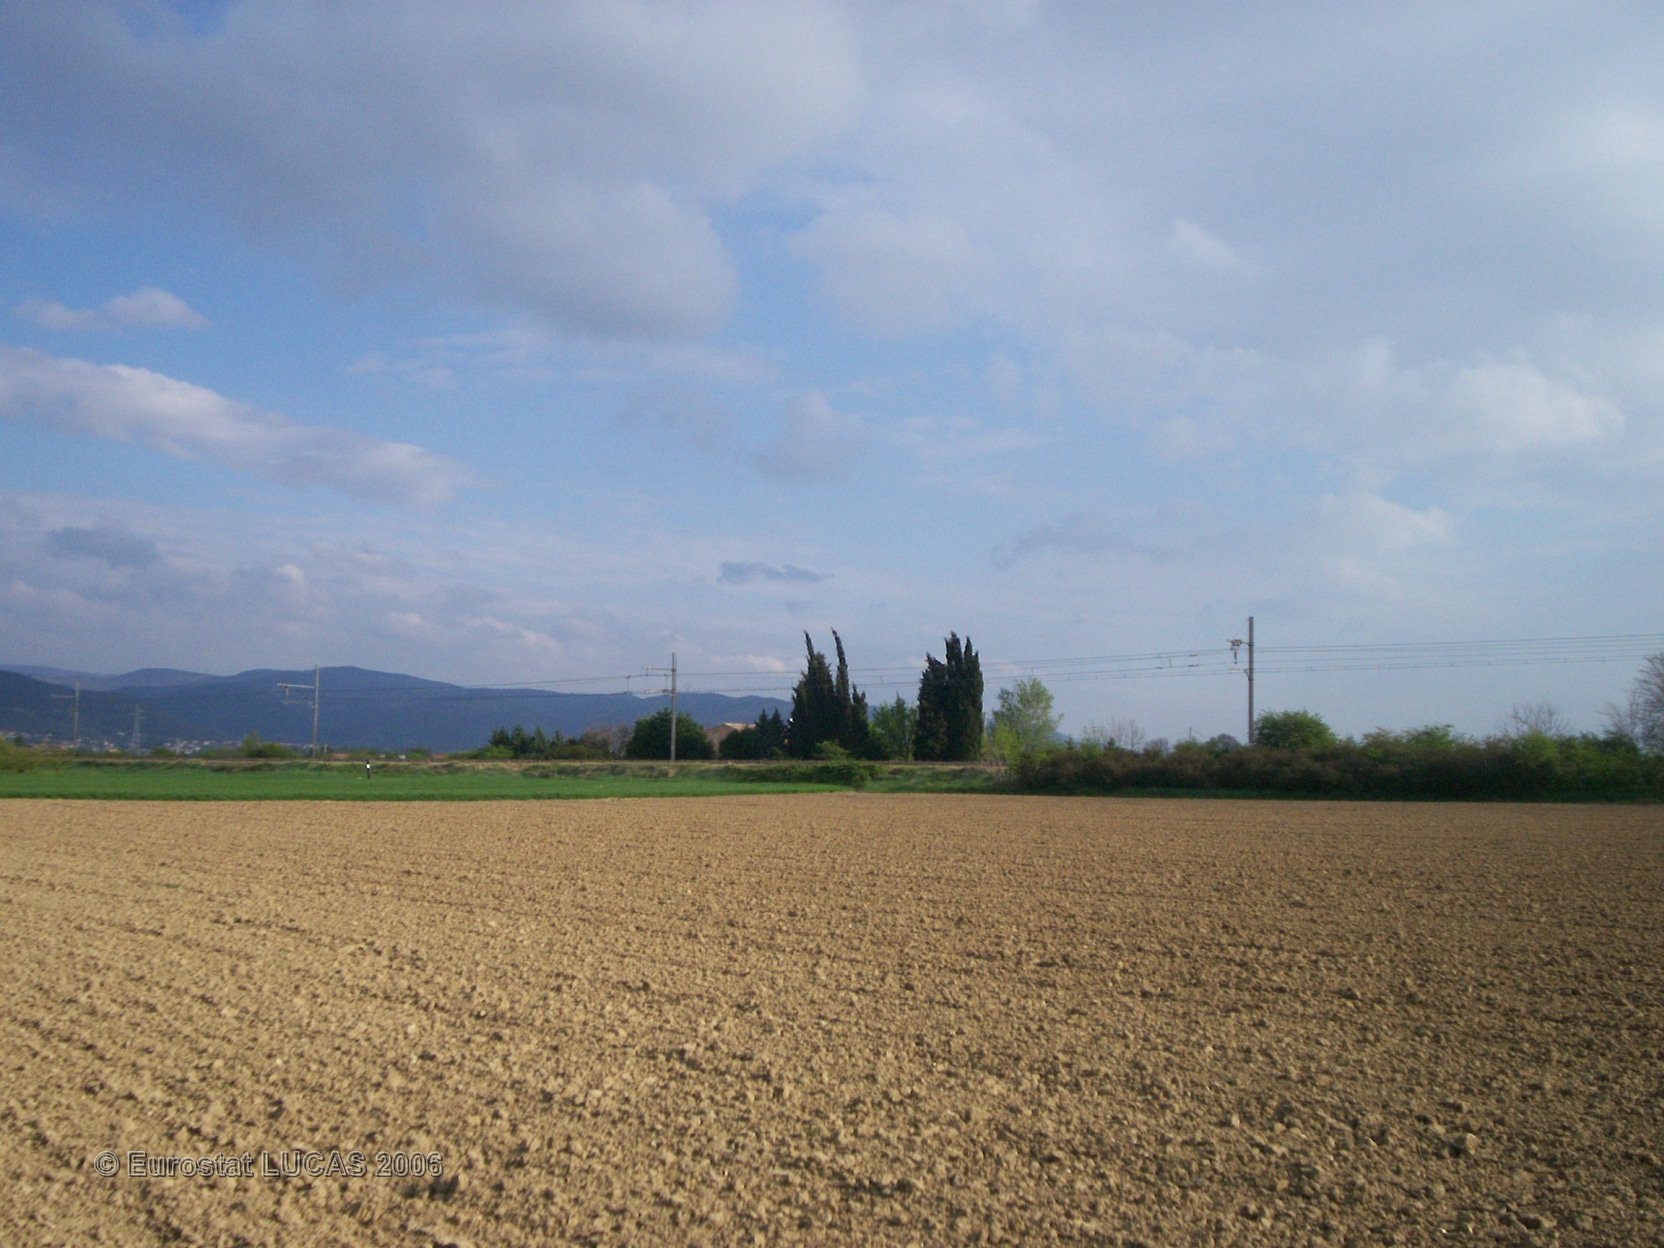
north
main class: Cropland
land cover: Sunflower
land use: Agriculture (excluding fallow land and kitchen gardens)
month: June
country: FR
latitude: 44.7809
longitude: 4.8120
